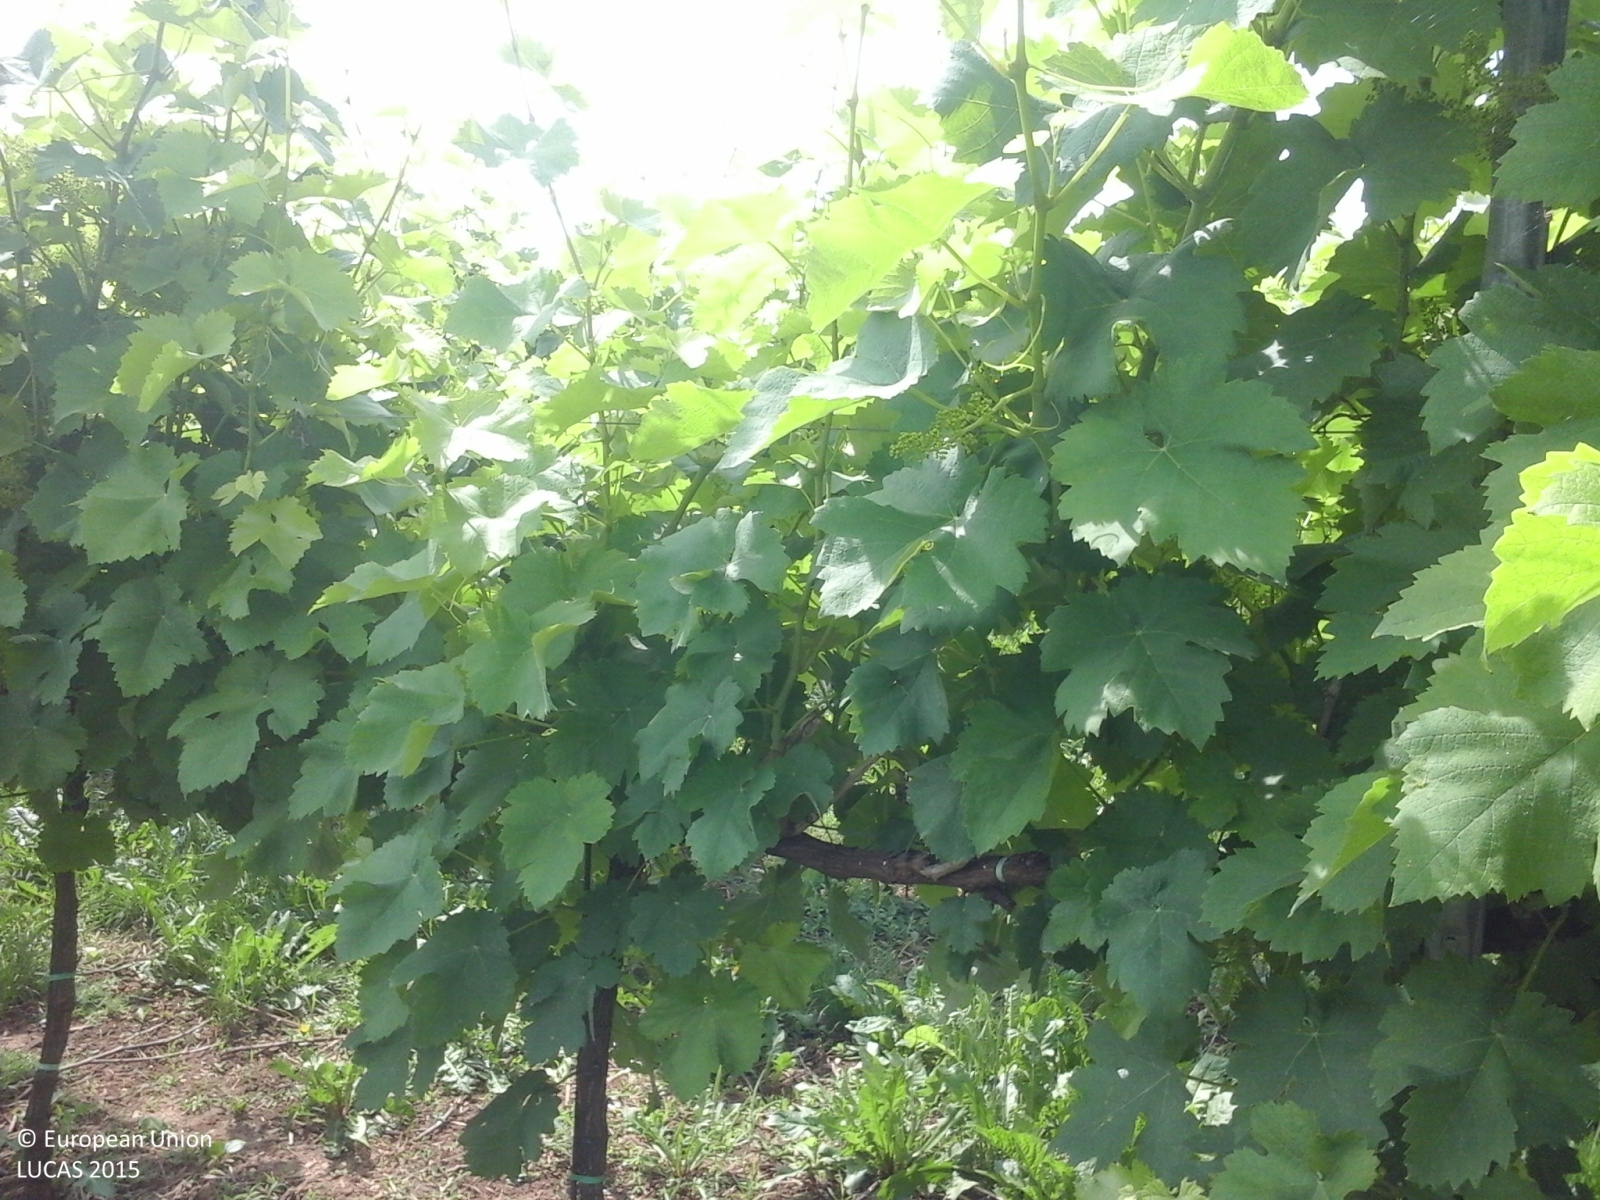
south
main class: Cropland
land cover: Vineyards
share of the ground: > 75 %
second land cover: Grassland without tree/shrub cover
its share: 50 - 75 %
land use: Agriculture (excluding fallow land and kitchen gardens)
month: May
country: IT
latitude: 45.4026
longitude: 11.5687
